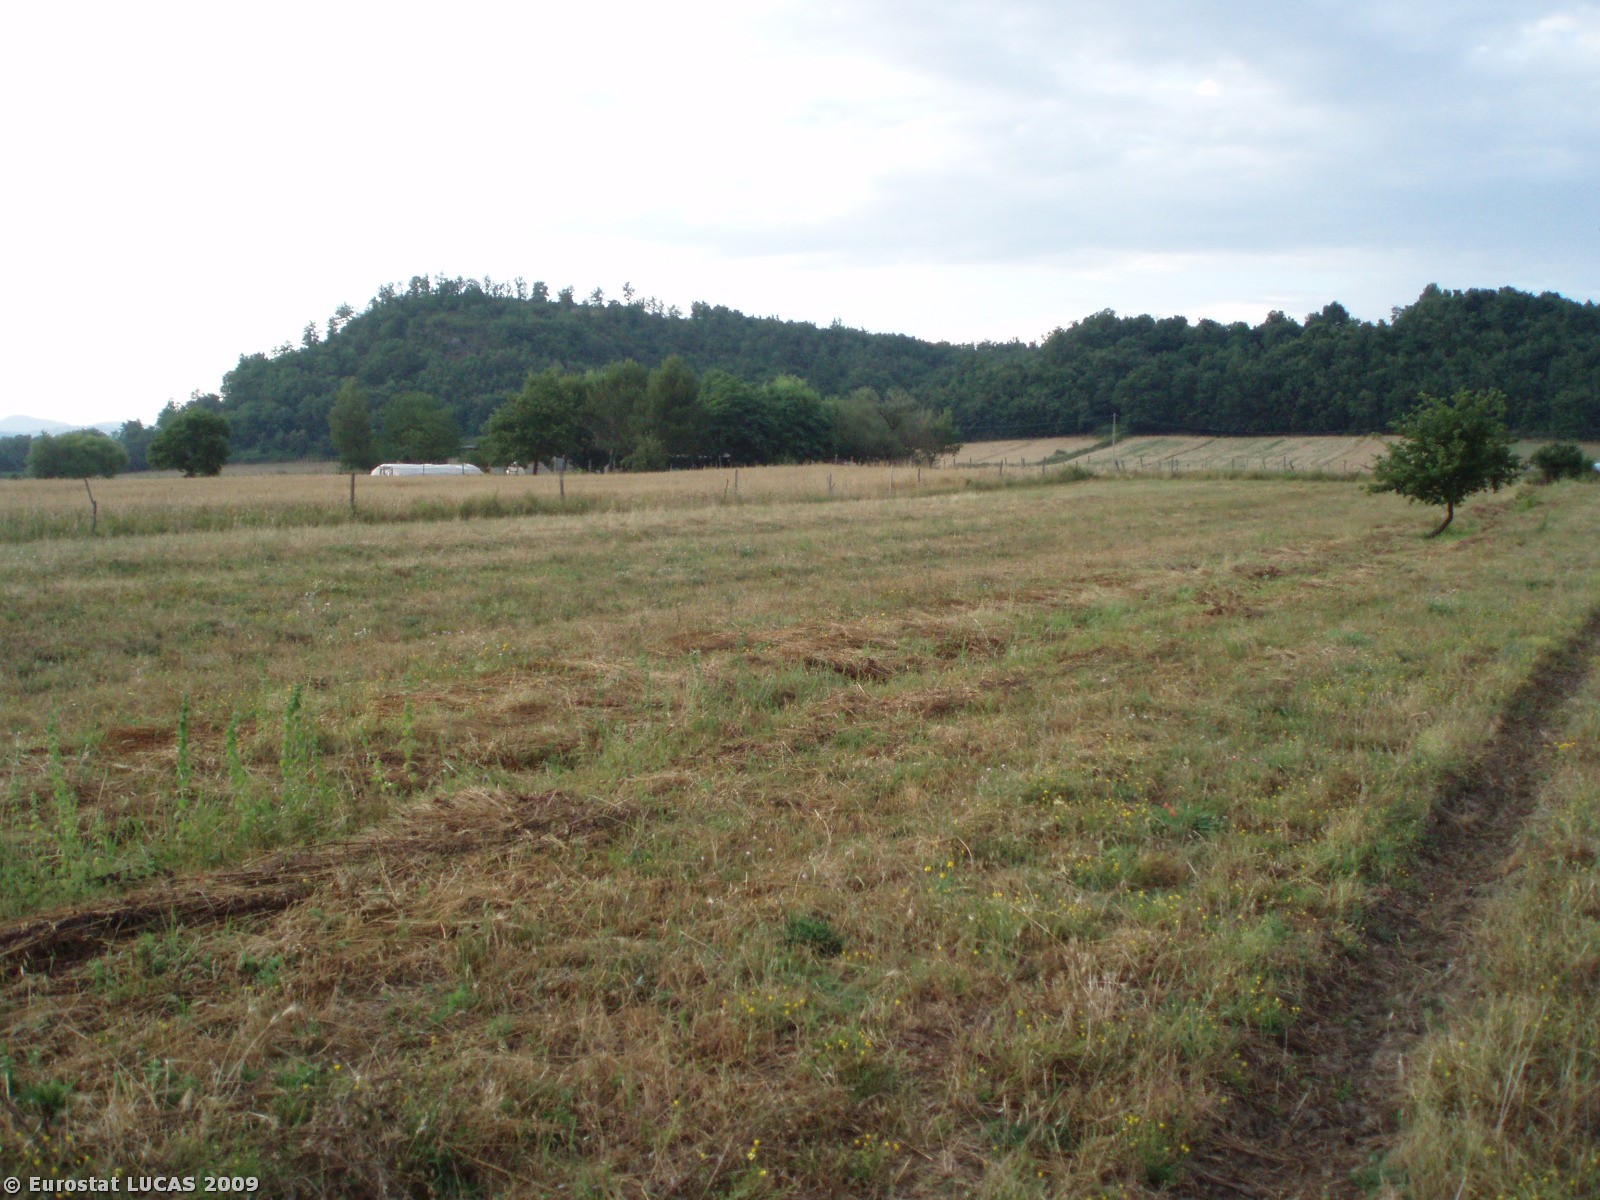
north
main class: Grassland
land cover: Grassland without tree/shrub cover
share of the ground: > 75 %
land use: Agriculture (excluding fallow land and kitchen gardens)
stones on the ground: < 10 %
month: June
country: IT
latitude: 42.6054
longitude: 11.5914
